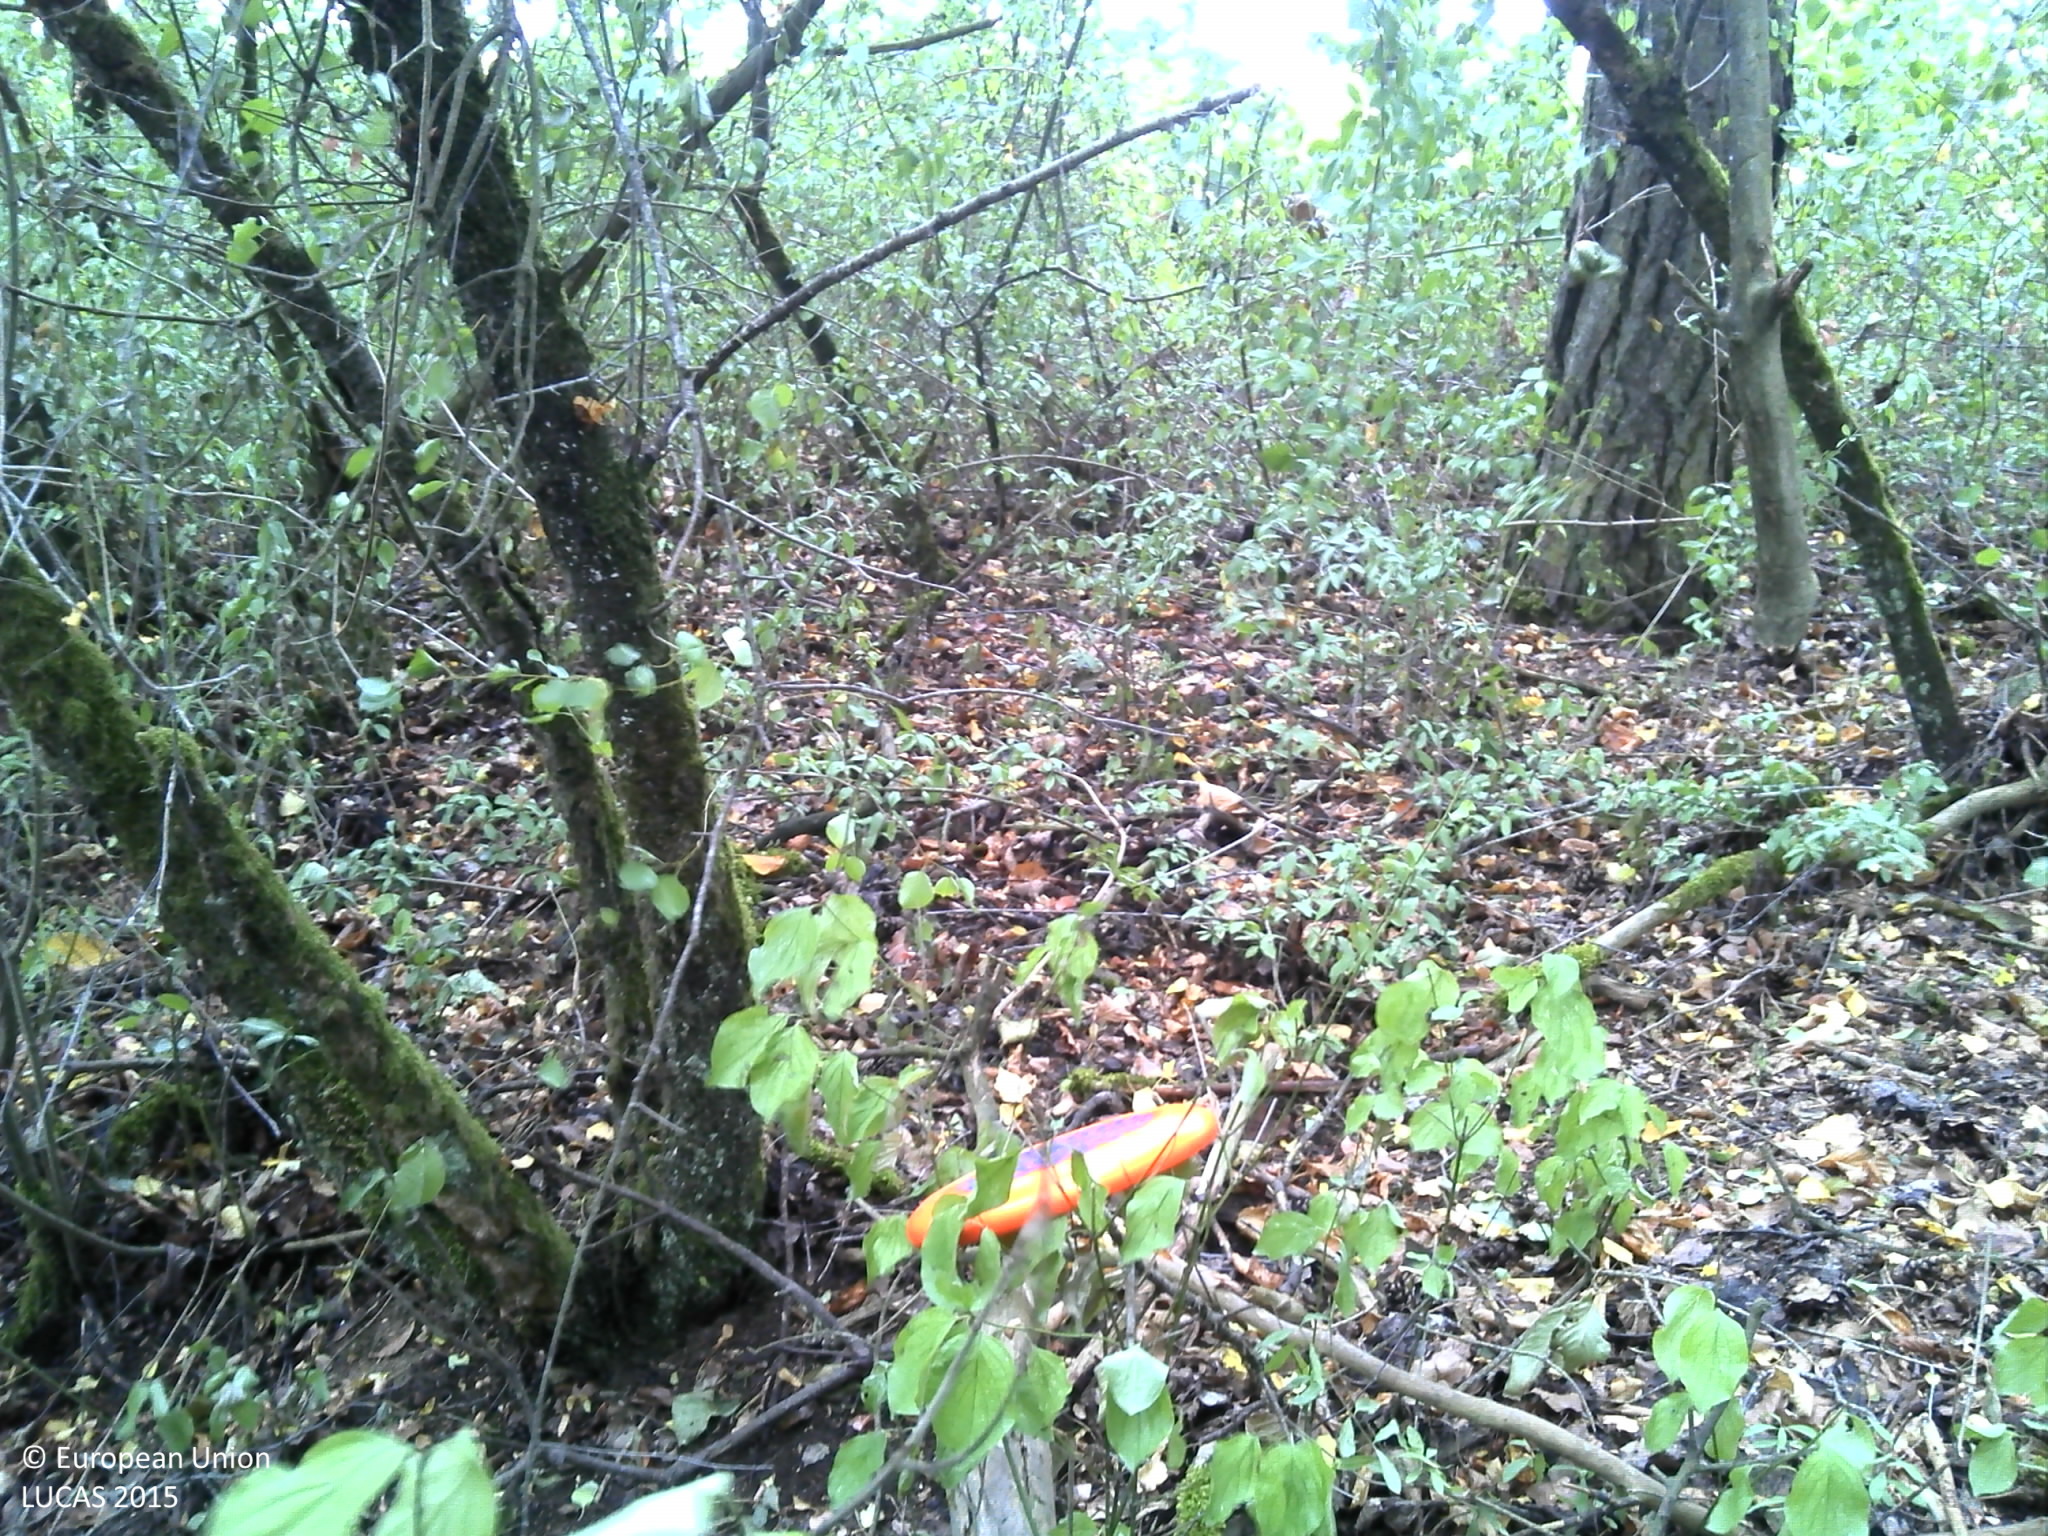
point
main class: Woodland
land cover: Broadleaved woodland
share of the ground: > 75 %
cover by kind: broadleaved forest trees 85 %, coniferous forest trees 10 %, herbaceous plants 5 %
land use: Forestry
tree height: > 5 m
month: August
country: FR
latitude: 48.8659
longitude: 4.5850
